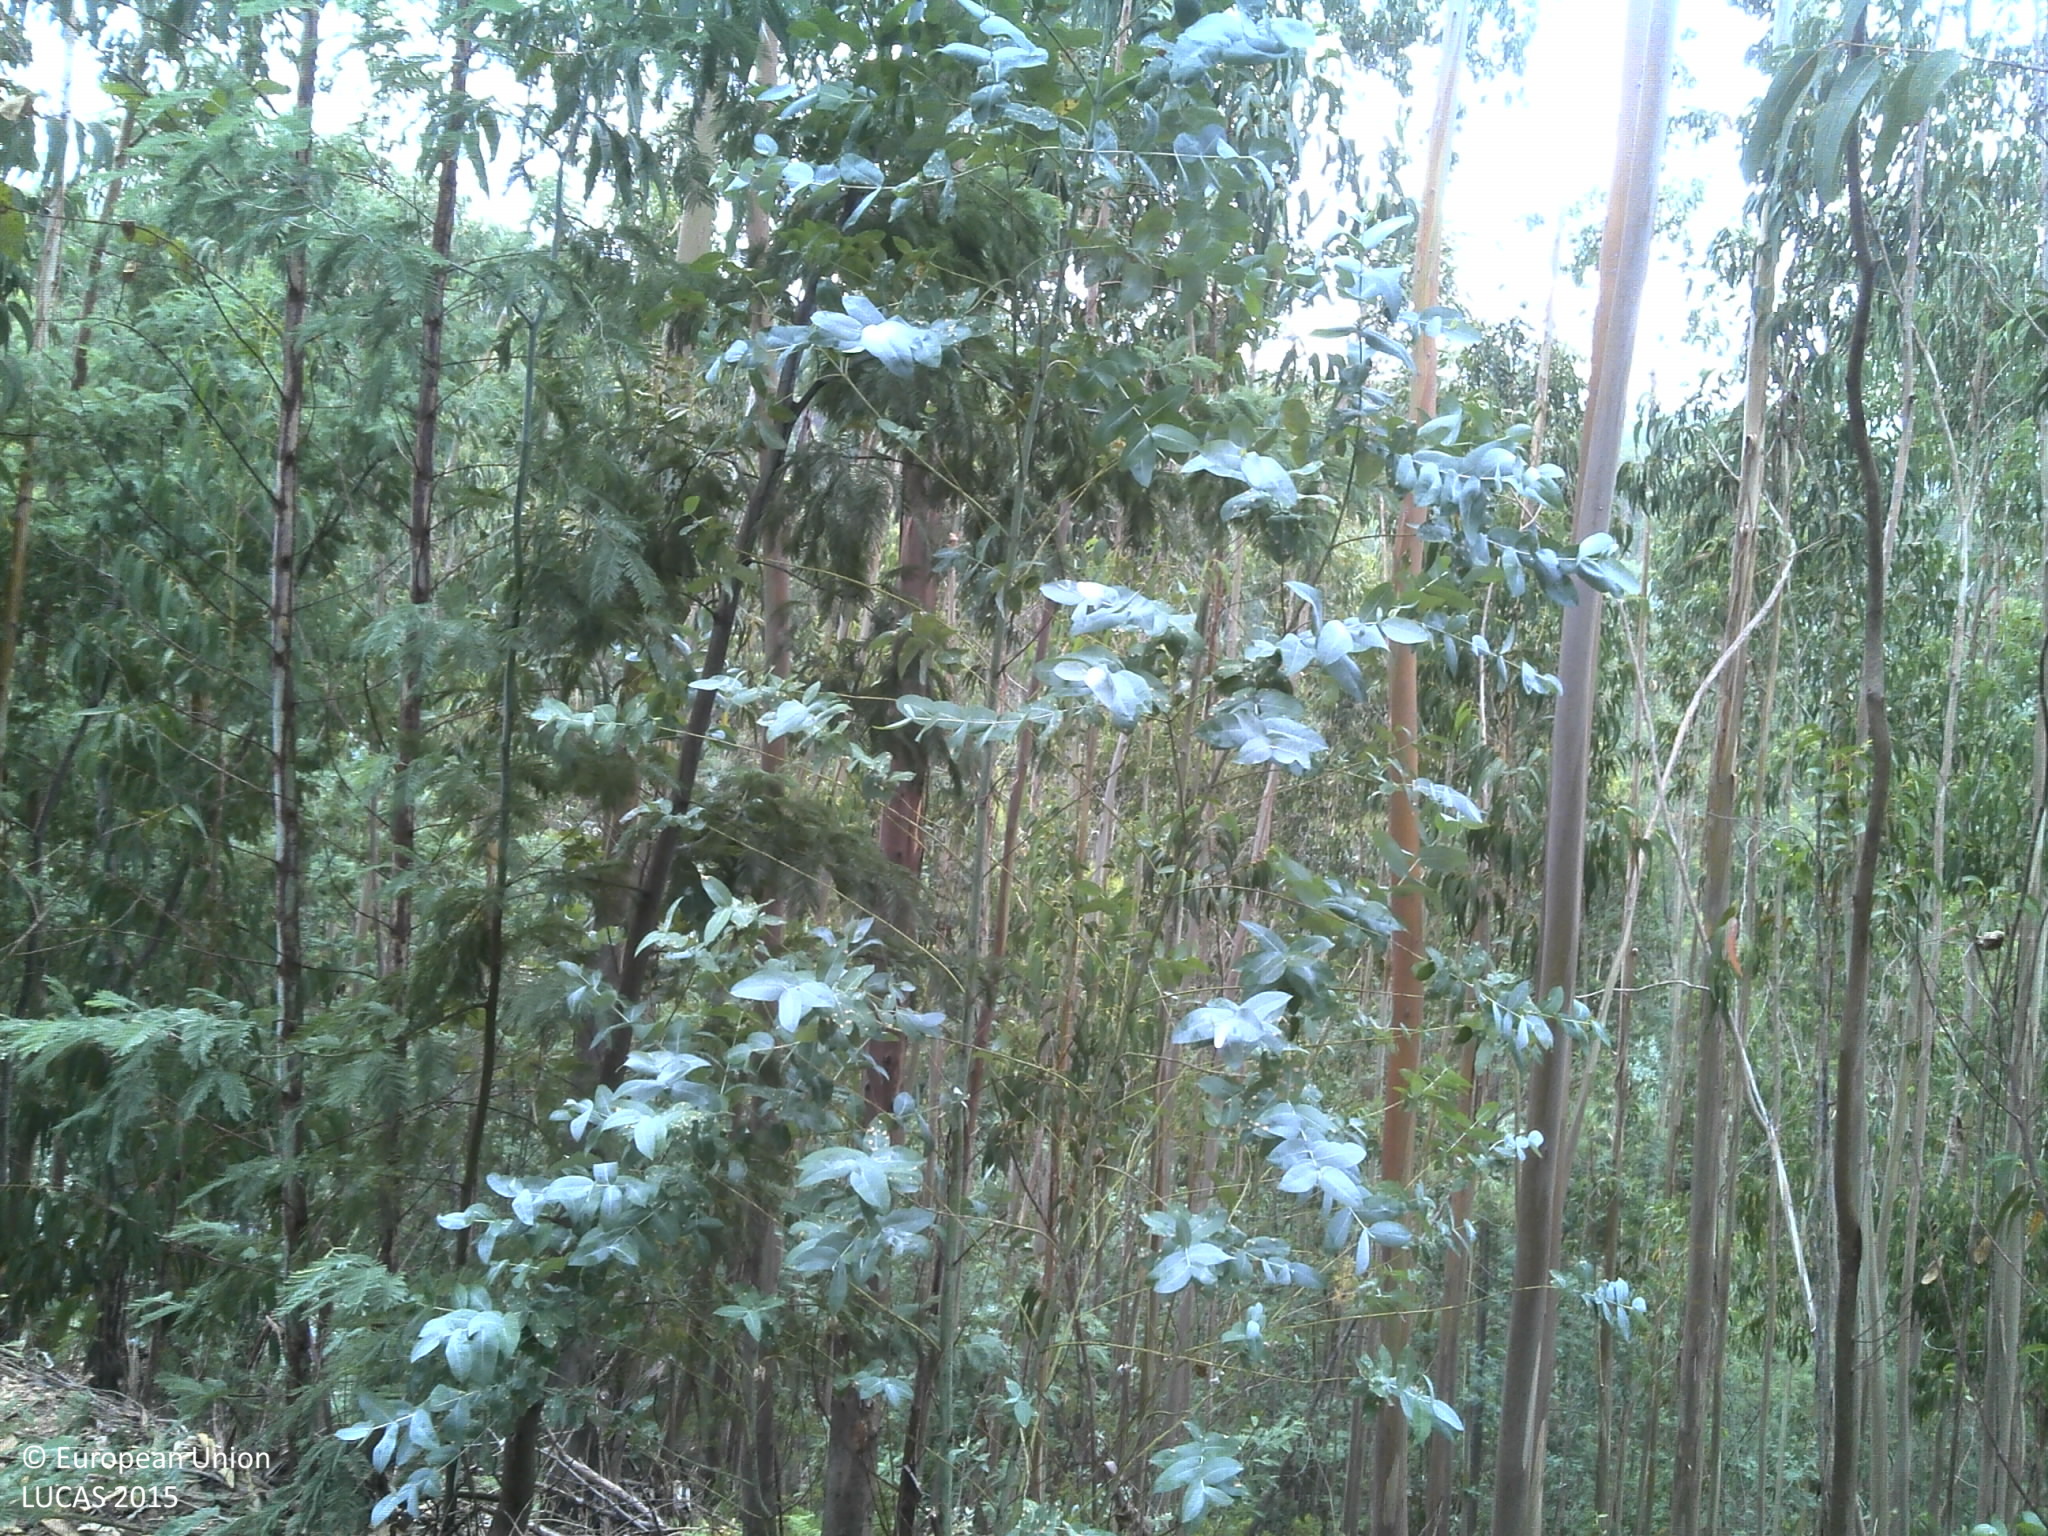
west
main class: Woodland
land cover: Broadleaved woodland
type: exotic forest
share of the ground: 50 - 75 %
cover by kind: broadleaved forest trees 60 %, consolidated bare surface 20 %, shrubs 10 %, unconsolidated bare surface 10 %
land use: Forestry
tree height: > 5 m
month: July
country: PT
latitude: 40.2902
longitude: -8.2785
